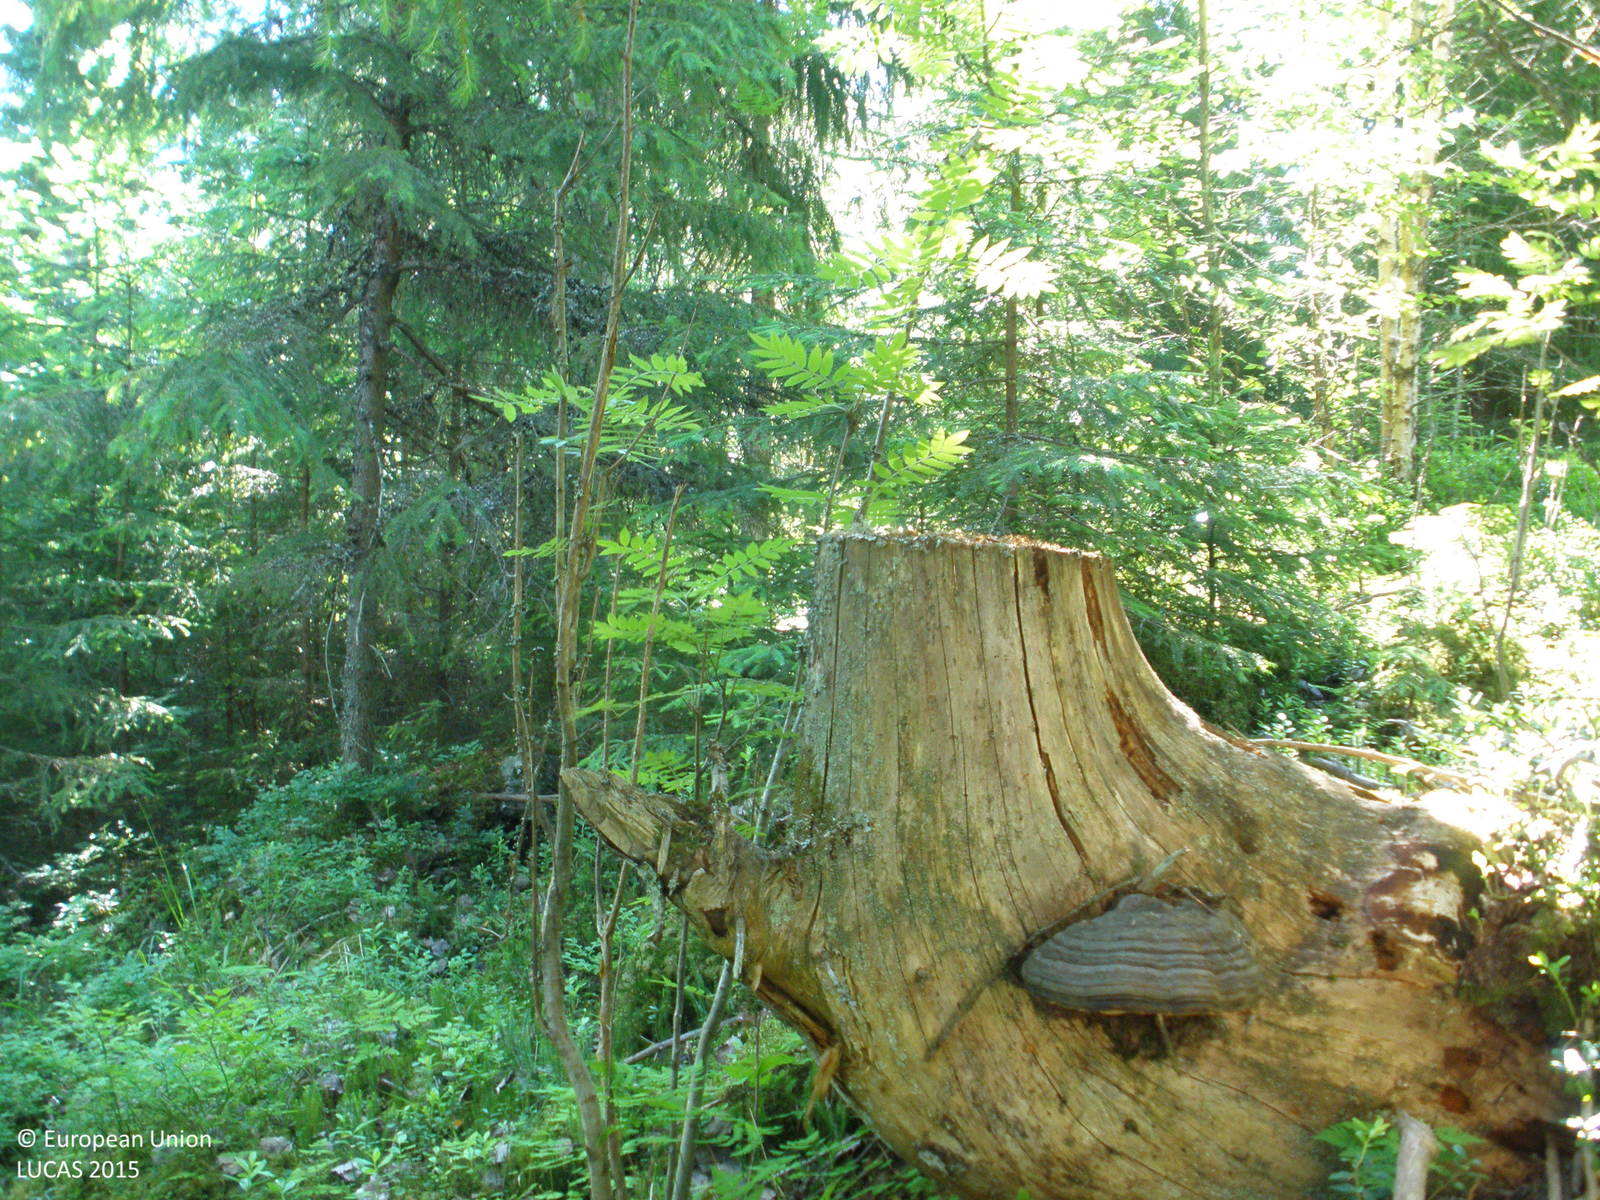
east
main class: Woodland
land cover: Spruce dominated mixed woodland
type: boreal forest
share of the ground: > 75 %
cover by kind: coniferous forest trees 60 %, broadleaved forest trees 25 %, herbaceous plants 10 %, lichens and mosses 5 %
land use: Forestry
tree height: > 5 m
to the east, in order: Spruce dominated mixed woodland; Inland fresh water bodies
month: July
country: FI
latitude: 61.2018
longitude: 23.6124
